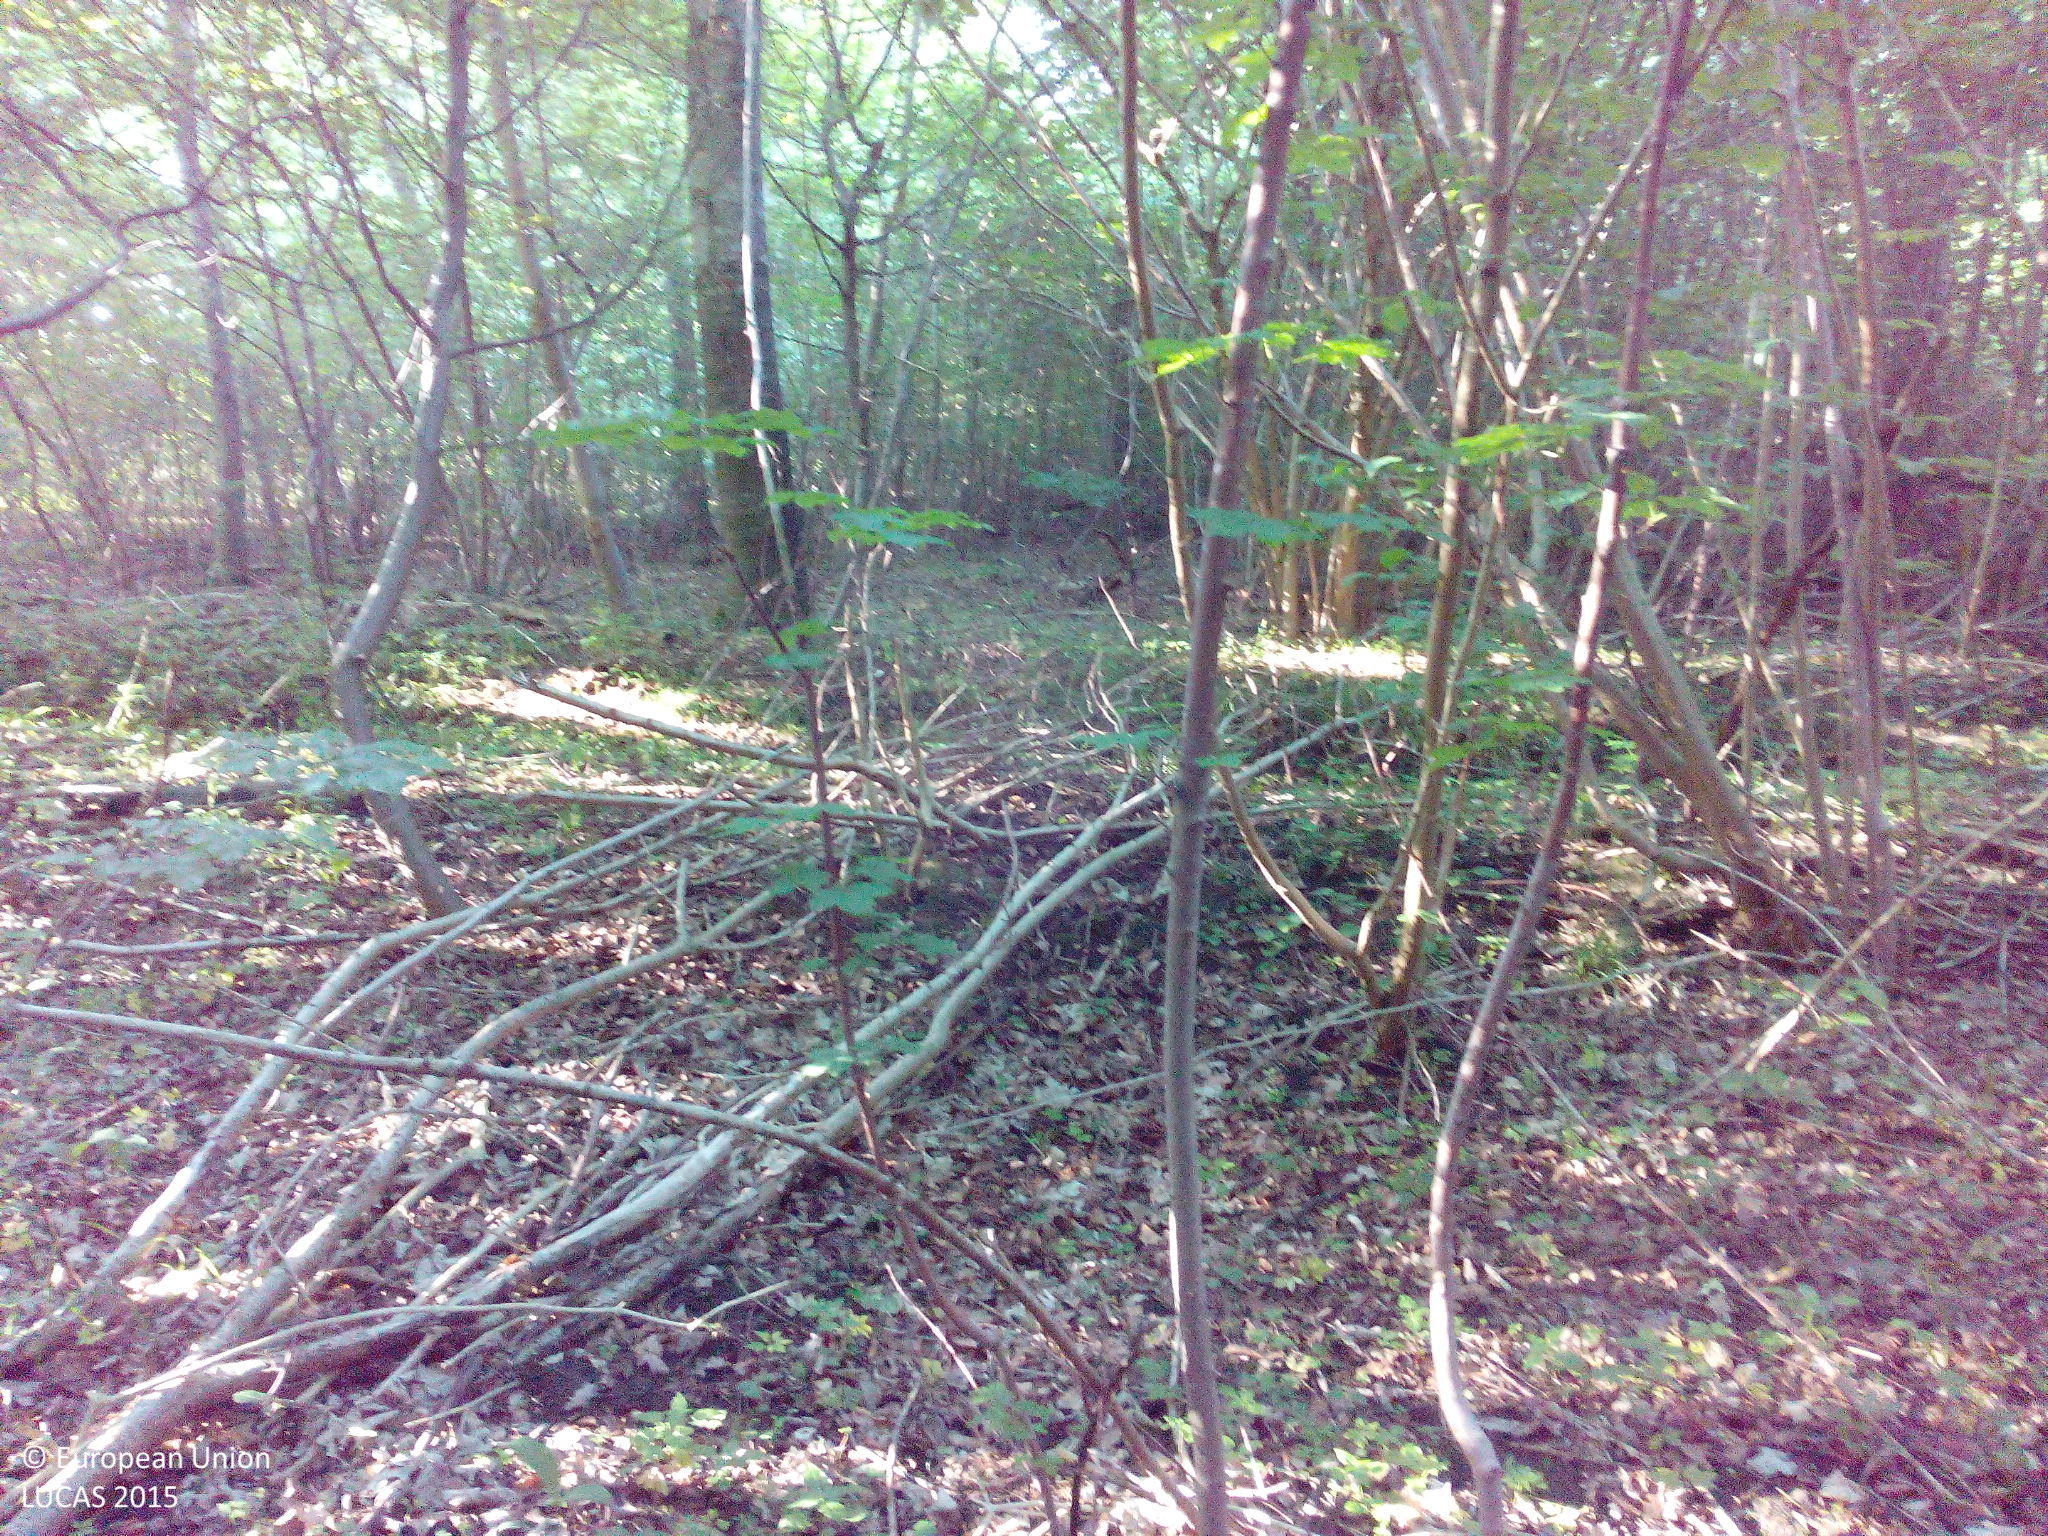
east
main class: Woodland
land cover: Broadleaved woodland
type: beech forest
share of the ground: > 75 %
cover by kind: broadleaved forest trees 100 %
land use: Forestry
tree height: > 5 m
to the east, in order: Broadleaved woodland; Ditches and canals; Broadleaved woodland; Ditches and canals; Broadleaved woodland; Tracks; Ditches and canals; Broadleaved woodland
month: June
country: DK
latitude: 54.7914
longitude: 11.7563
